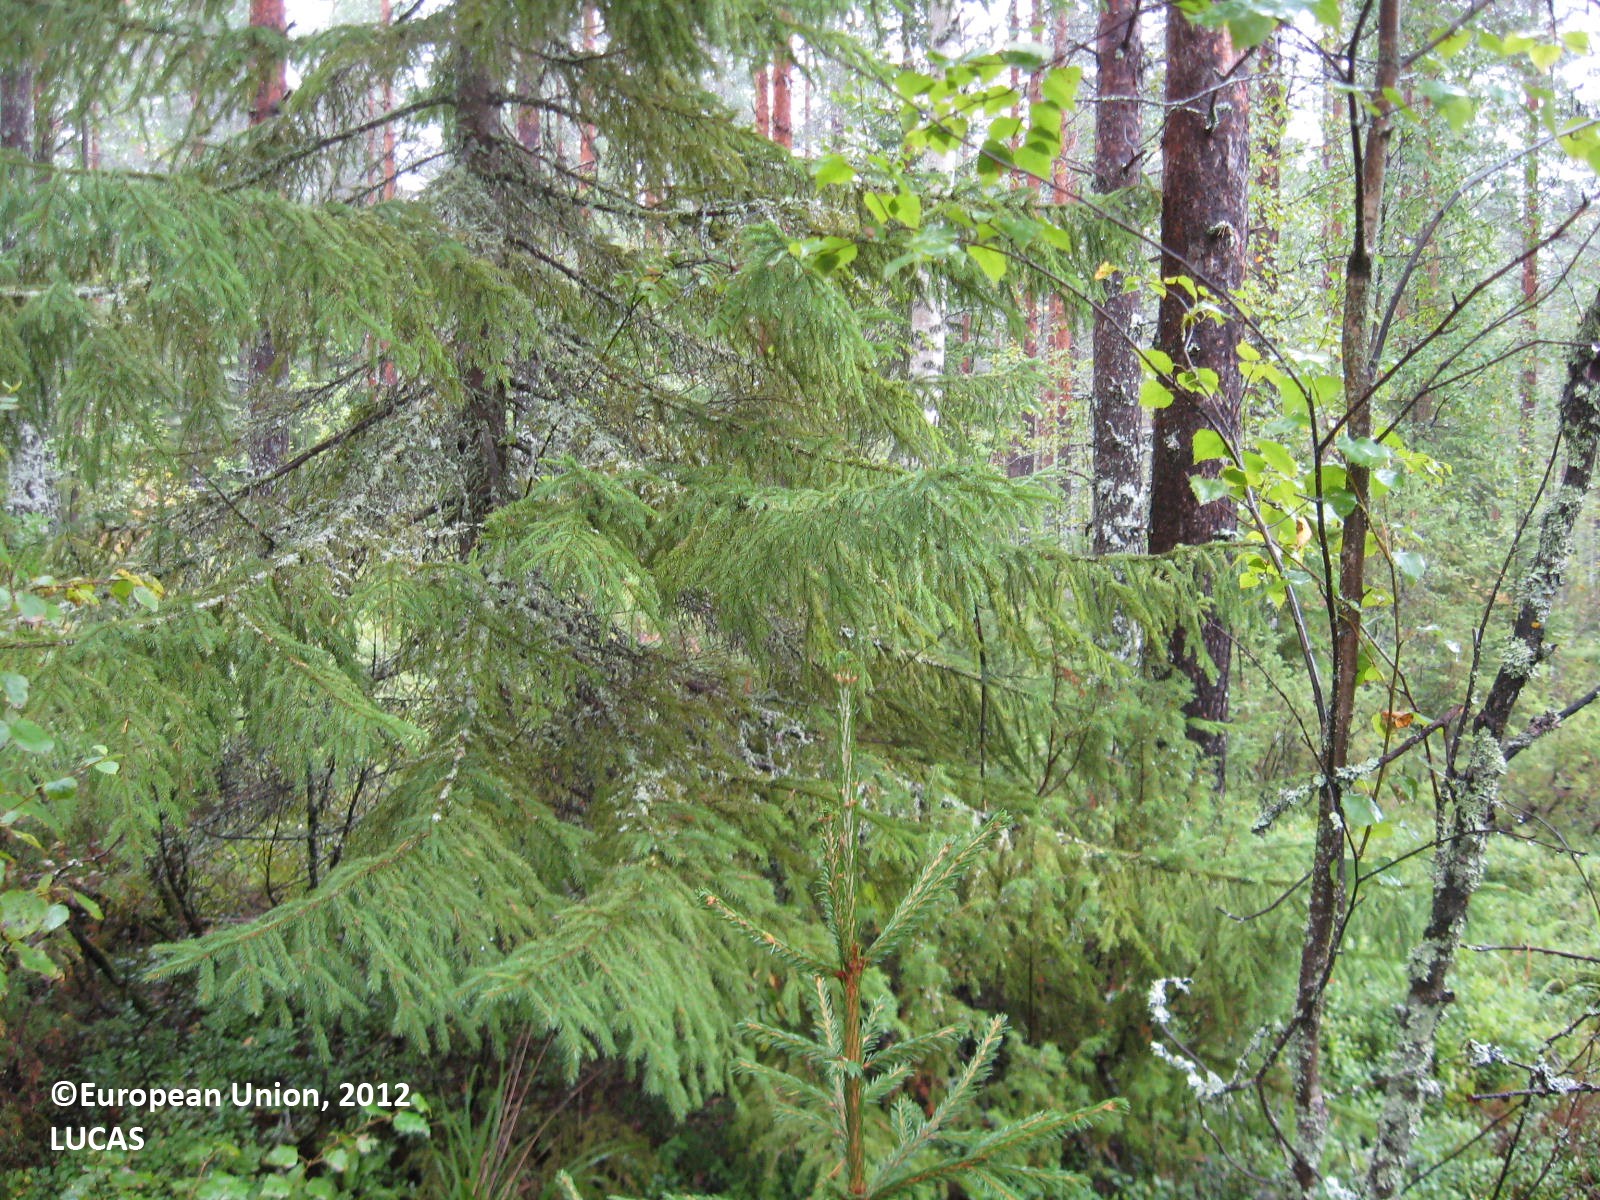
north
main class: Woodland
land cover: Pine dominated coniferous woodland
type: boreal forest
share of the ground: > 75 %
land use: Forestry
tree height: > 5 m
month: August
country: FI
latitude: 63.5671
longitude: 29.4534
